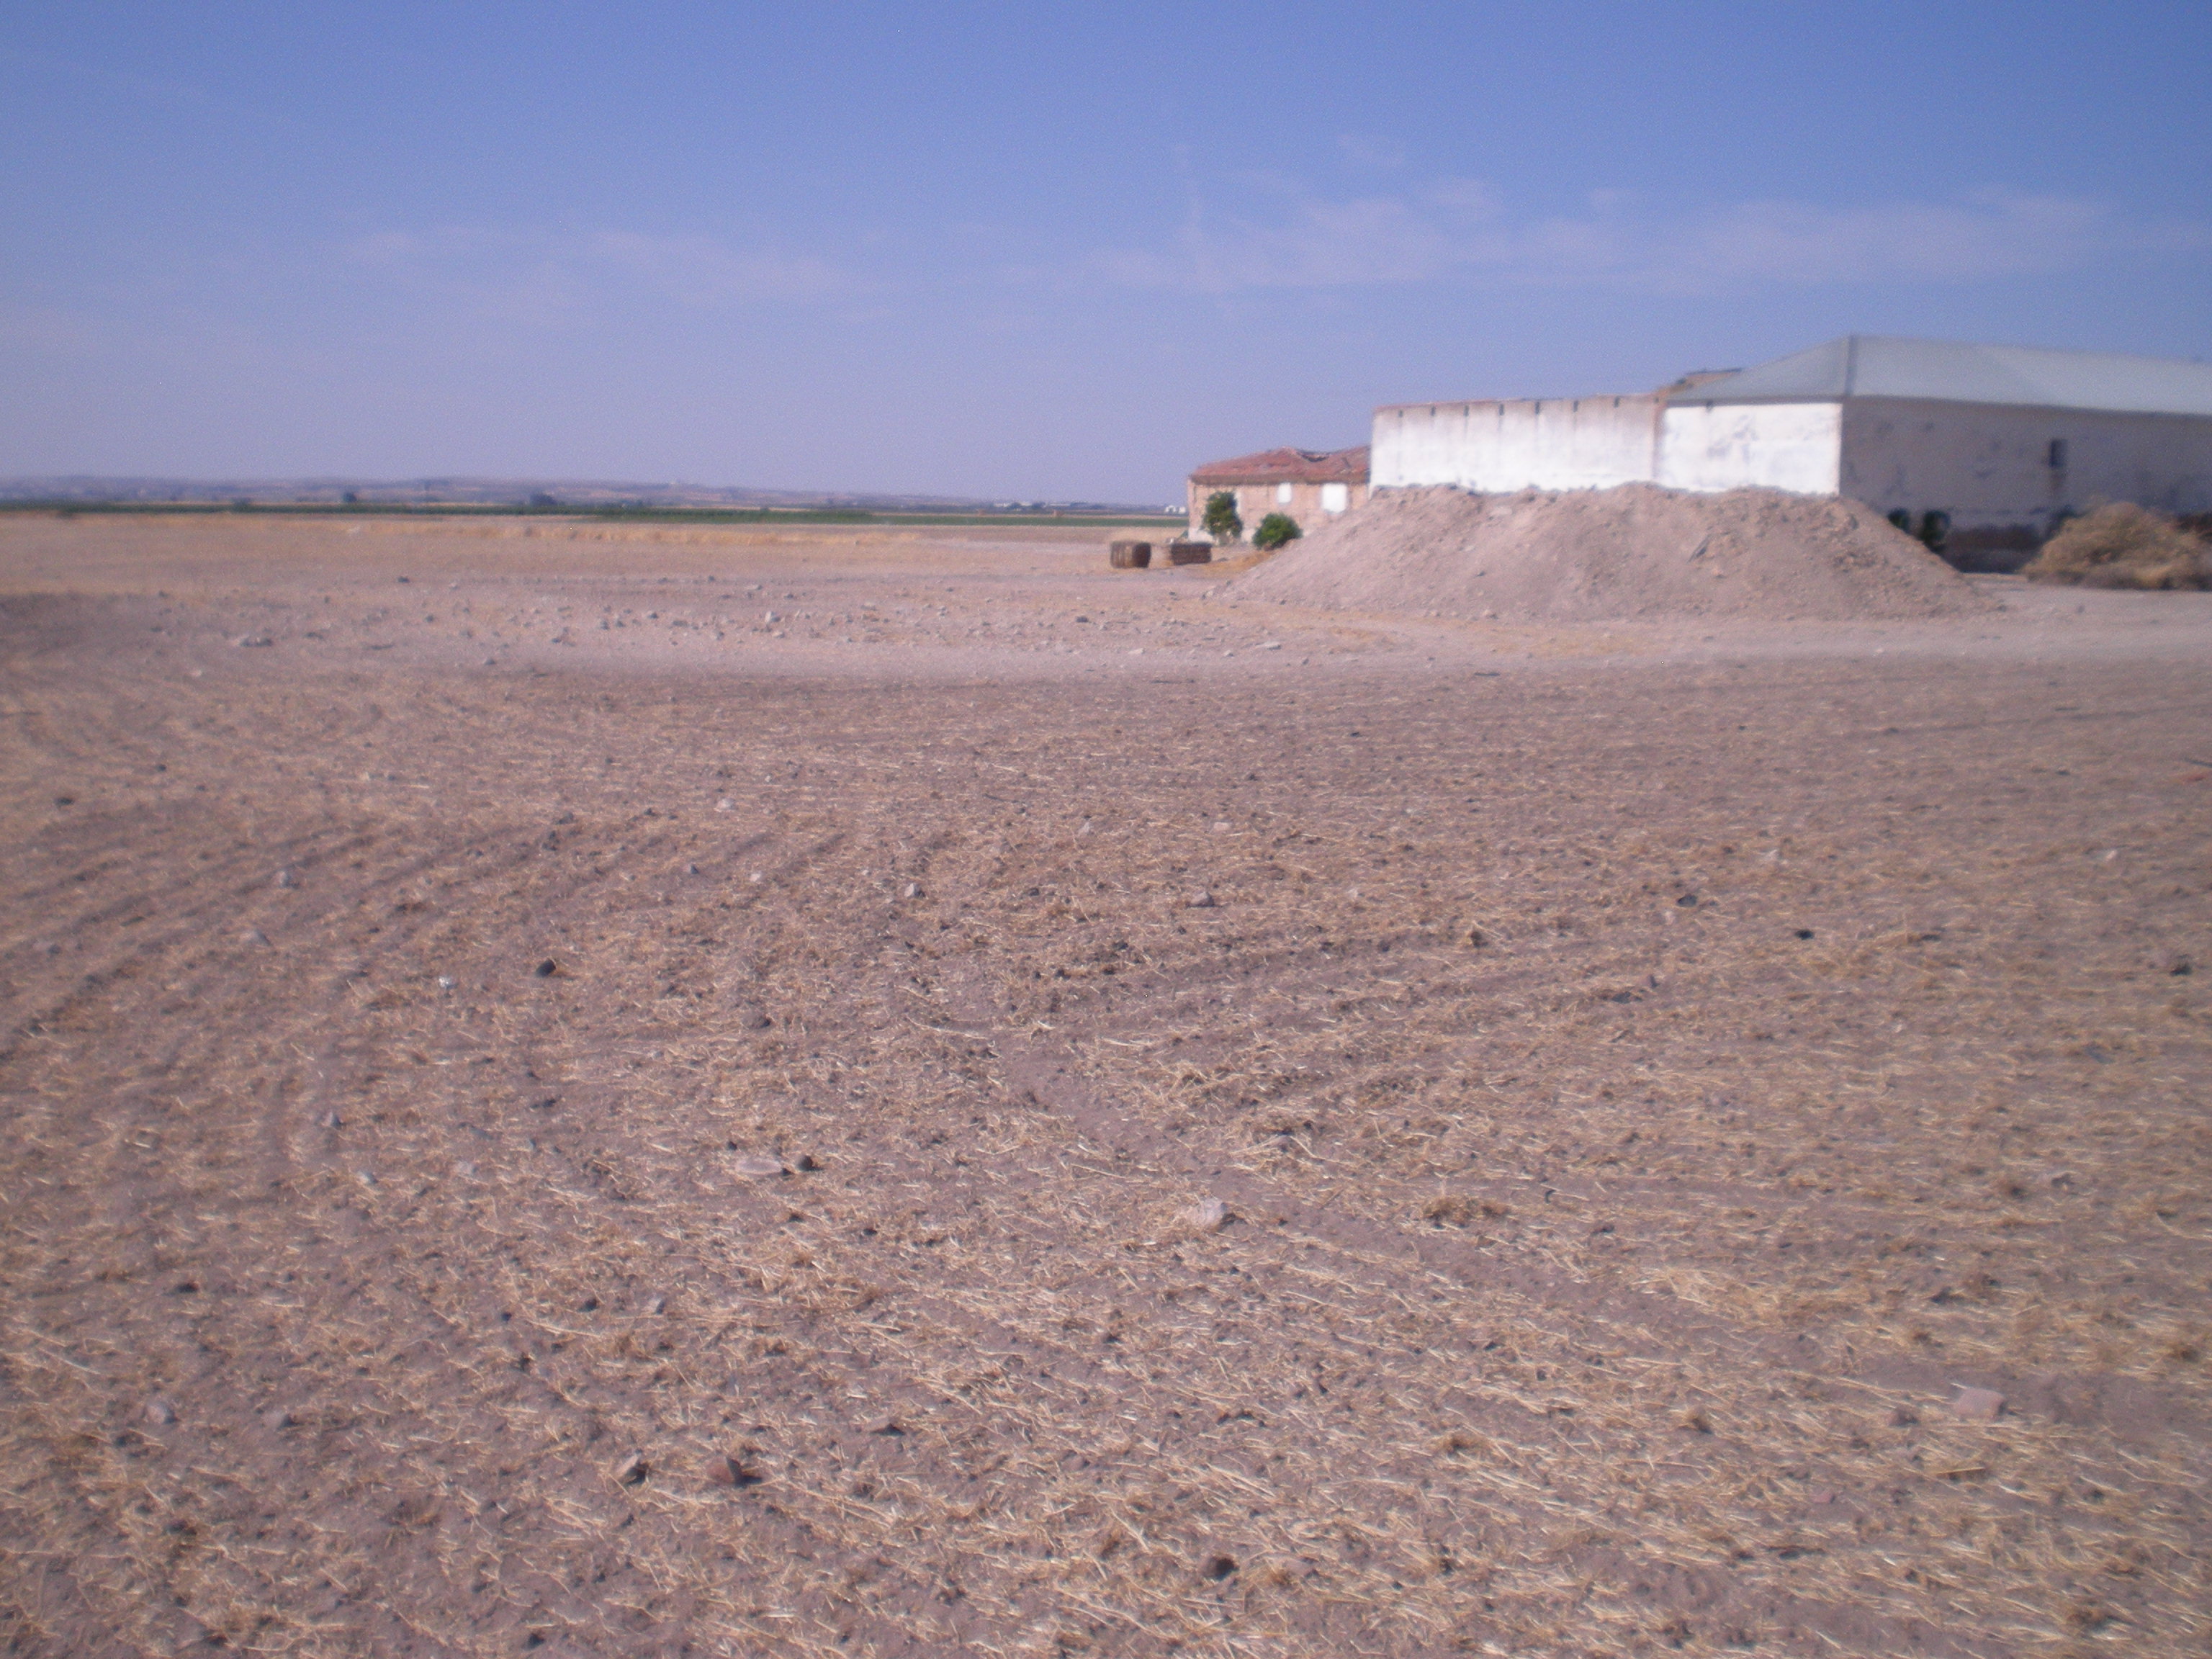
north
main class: Cropland
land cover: Barley
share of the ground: < 10 %
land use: Agriculture (excluding fallow land and kitchen gardens)
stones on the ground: < 10 %
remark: Harvested field
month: July
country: ES
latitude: 39.3103
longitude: -3.1093
